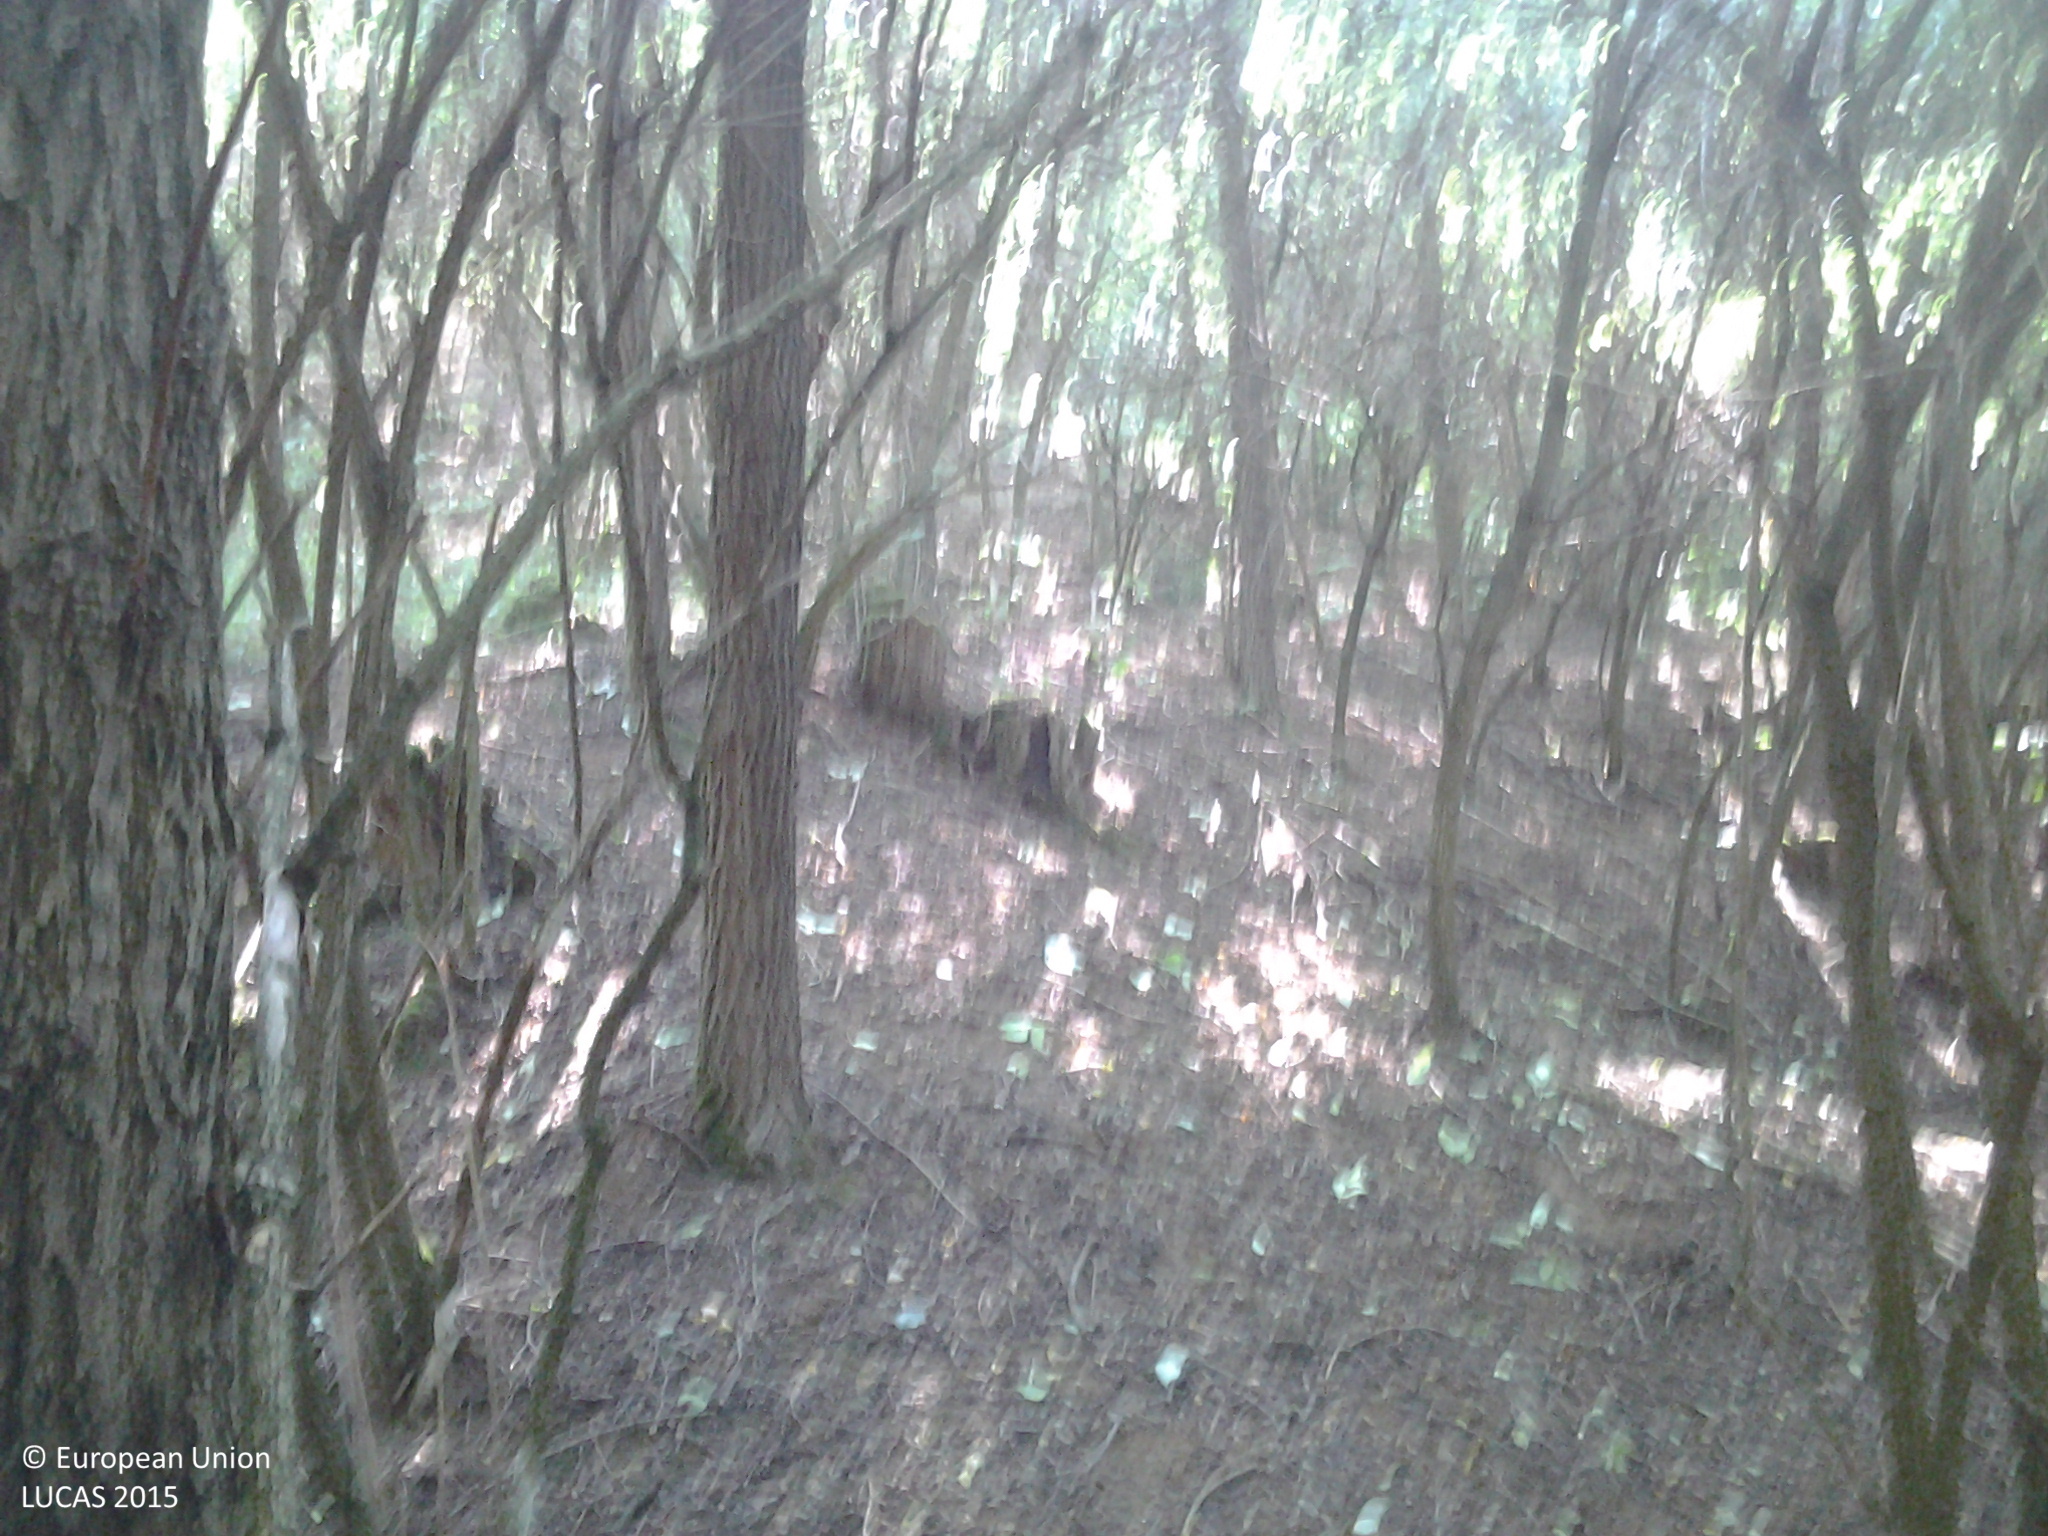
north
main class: Woodland
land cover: Broadleaved woodland
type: mesophytic deciduous forest
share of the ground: > 75 %
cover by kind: broadleaved forest trees 80 %, shrubs 20 %
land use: Forestry
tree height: > 5 m
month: August
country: HU
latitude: 48.0095
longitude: 19.9337
